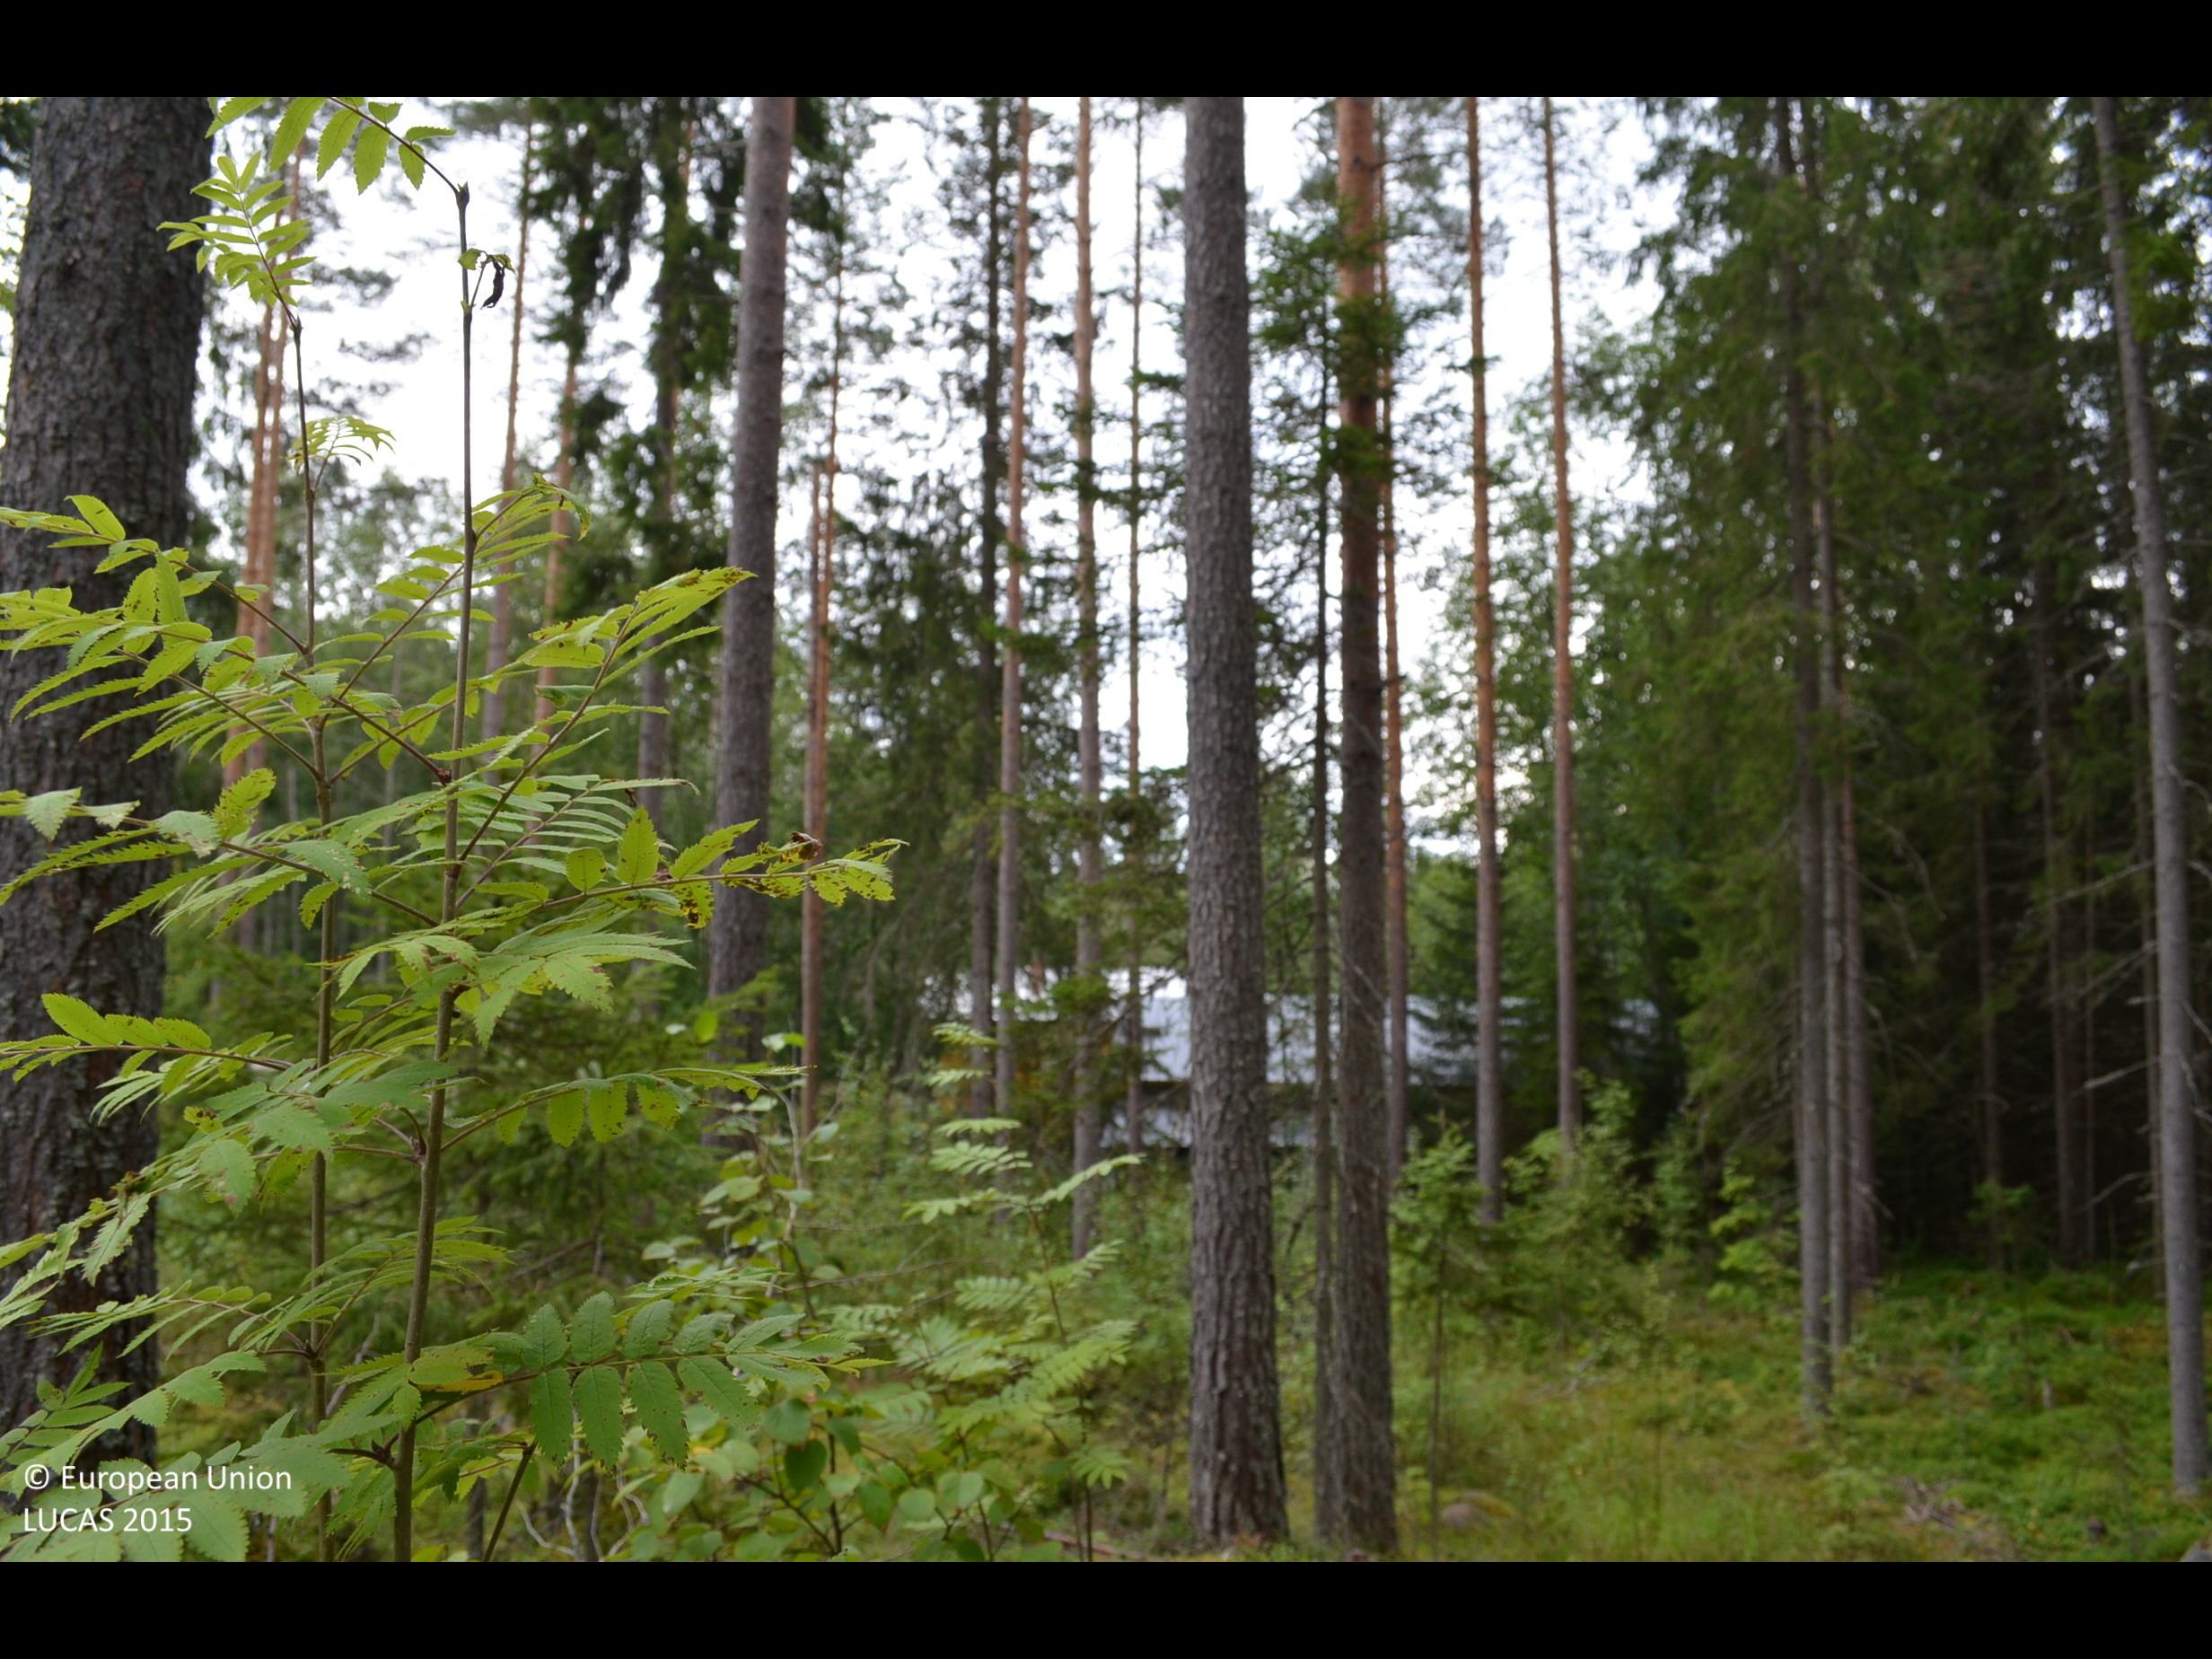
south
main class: Woodland
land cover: Pine dominated coniferous woodland
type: boreal forest
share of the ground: 50 - 75 %
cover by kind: coniferous forest trees 45 %, shrubs 30 %, broadleaved forest trees 10 %, herbaceous plants 10 %
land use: Forestry
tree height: > 5 m
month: August
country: FI
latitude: 62.2086
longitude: 24.2173
